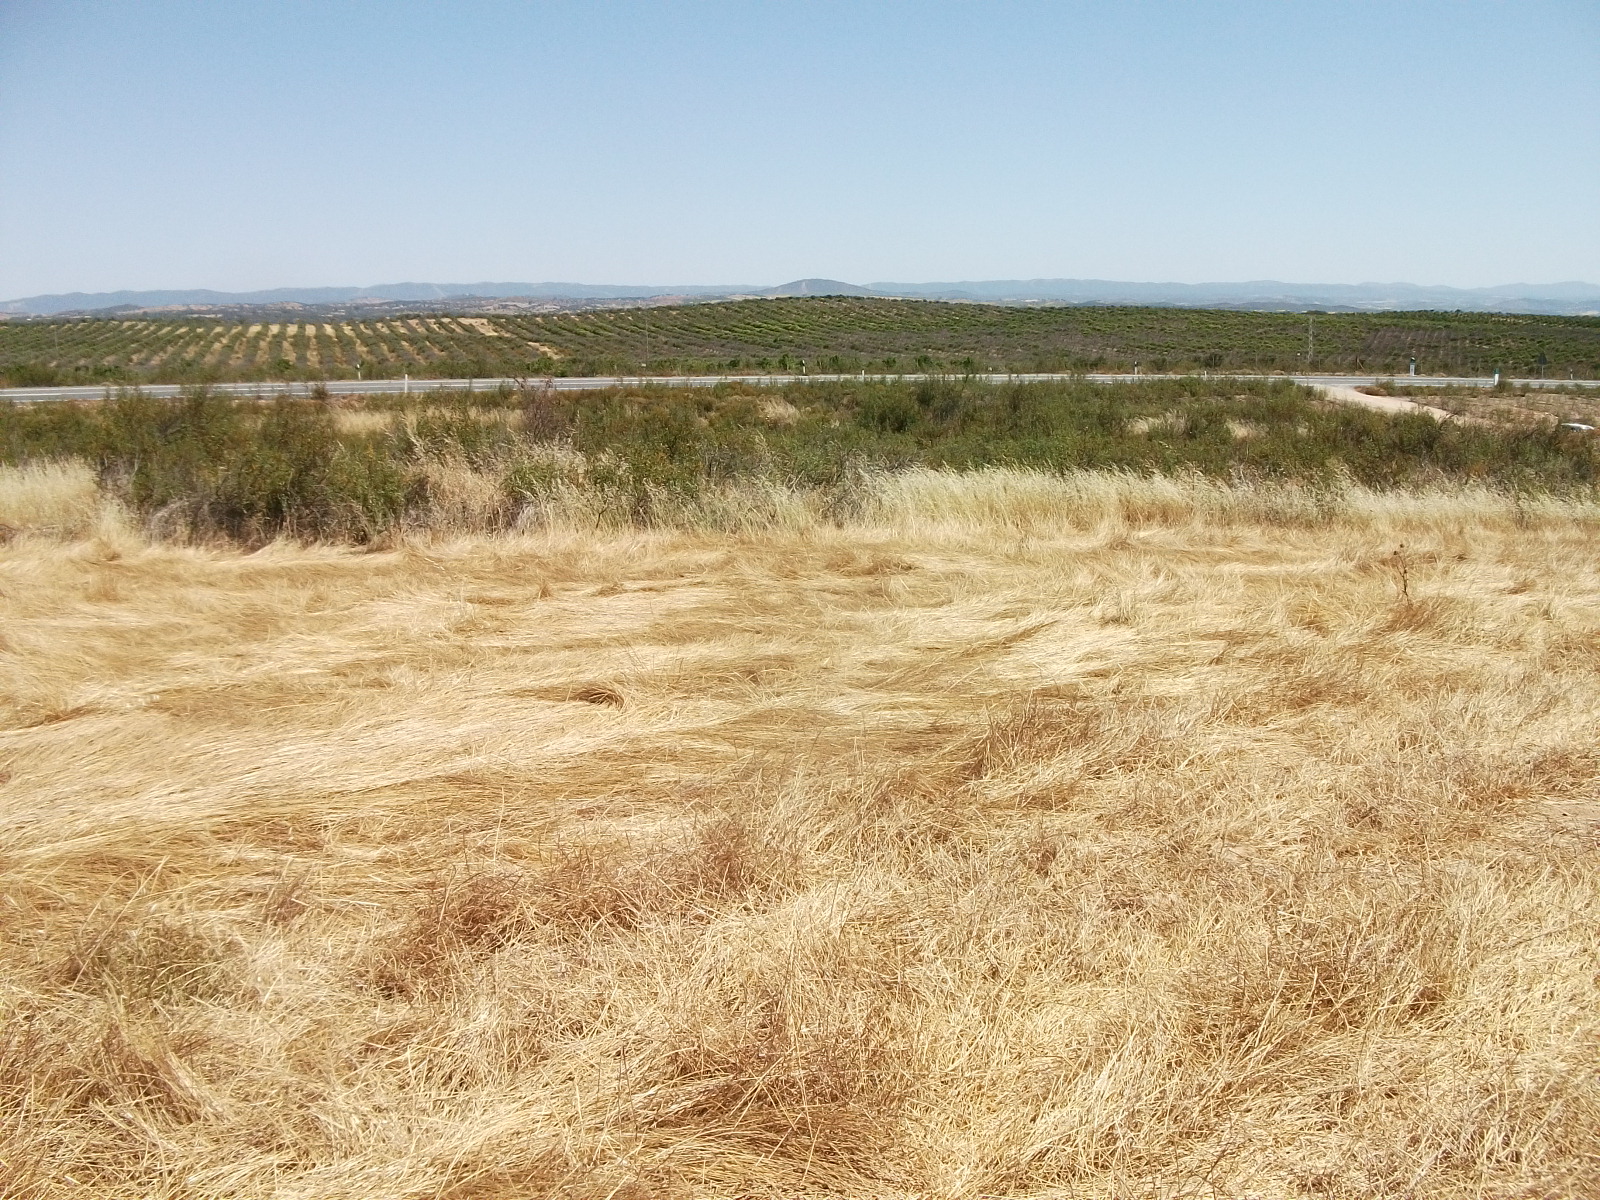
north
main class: Grassland
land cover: Grassland without tree/shrub cover
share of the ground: > 75 %
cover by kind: herbaceous plants 100 %
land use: Agriculture (excluding fallow land and kitchen gardens)
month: June
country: ES
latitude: 37.6095
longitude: -7.0971
